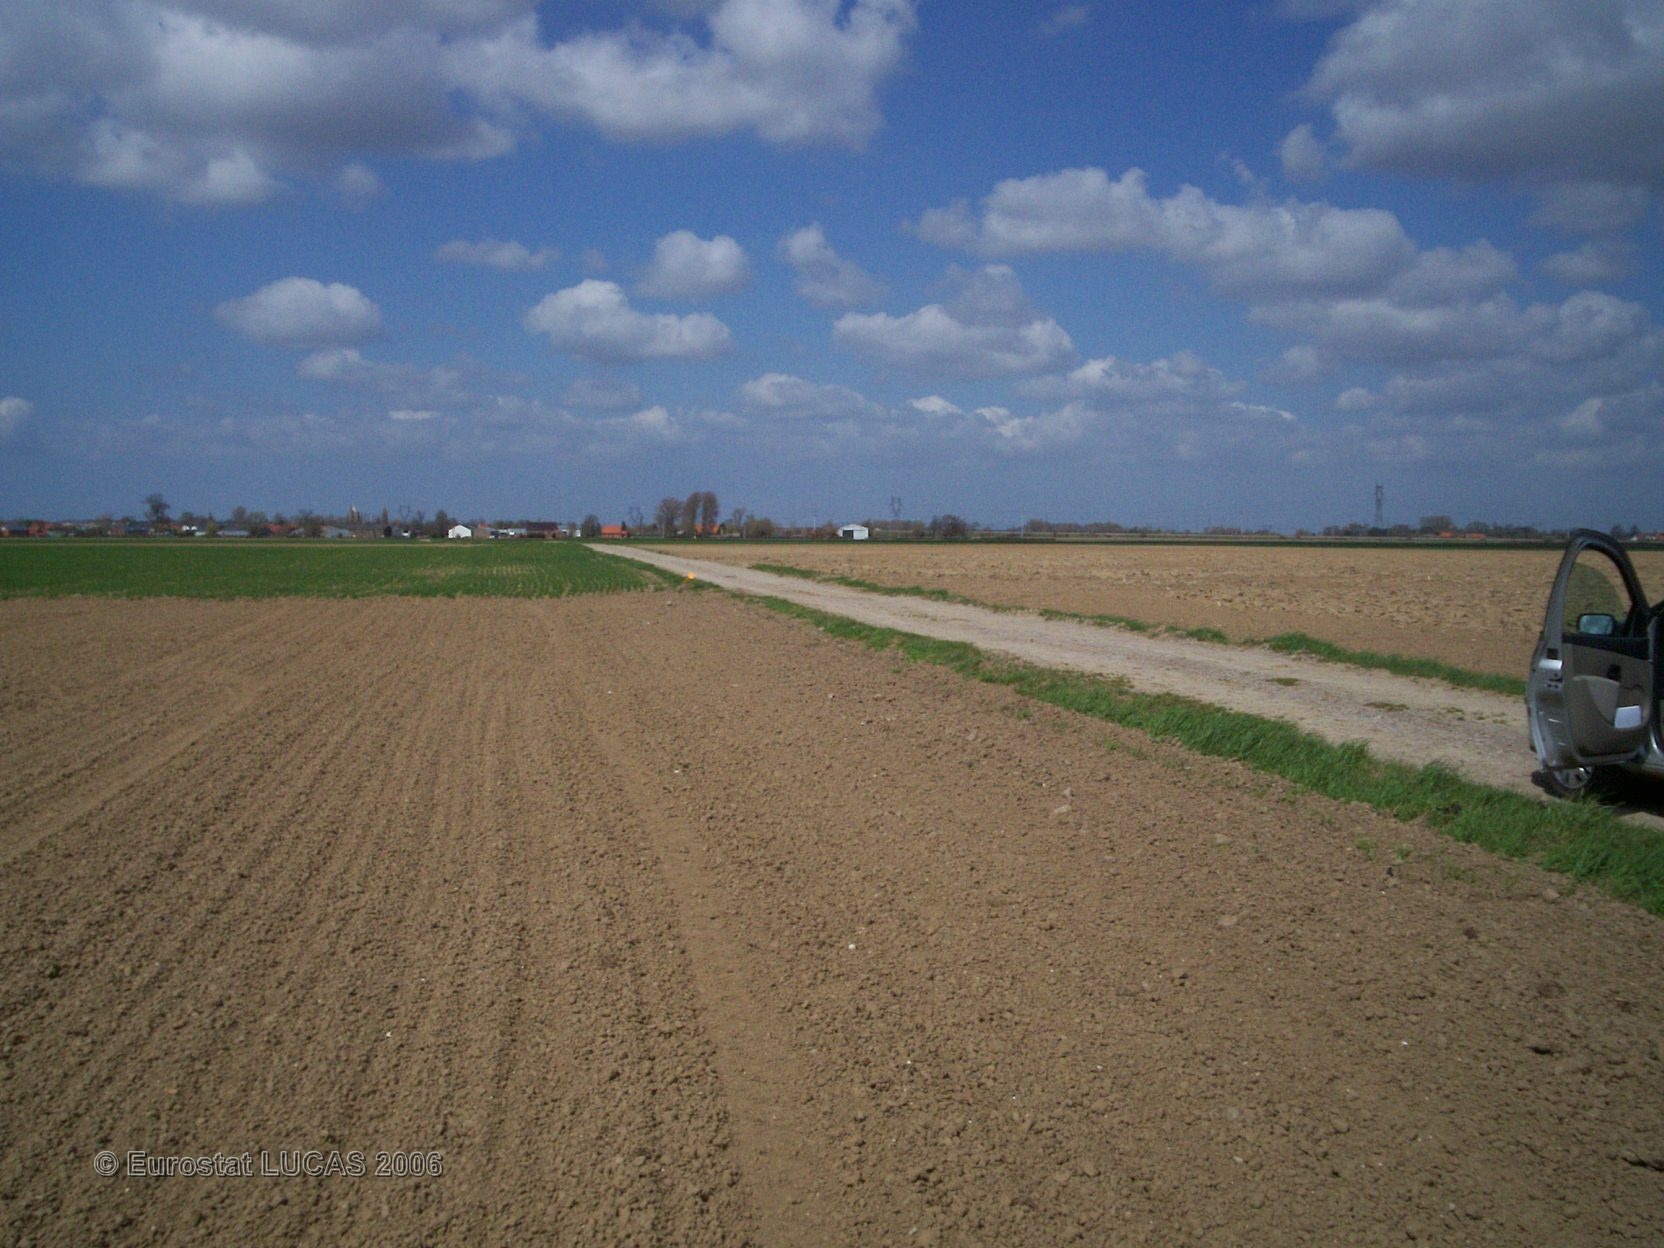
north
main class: Cropland
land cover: Sugar beet
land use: Agriculture (excluding fallow land and kitchen gardens)
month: May
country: FR
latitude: 50.8093
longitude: 2.3085
